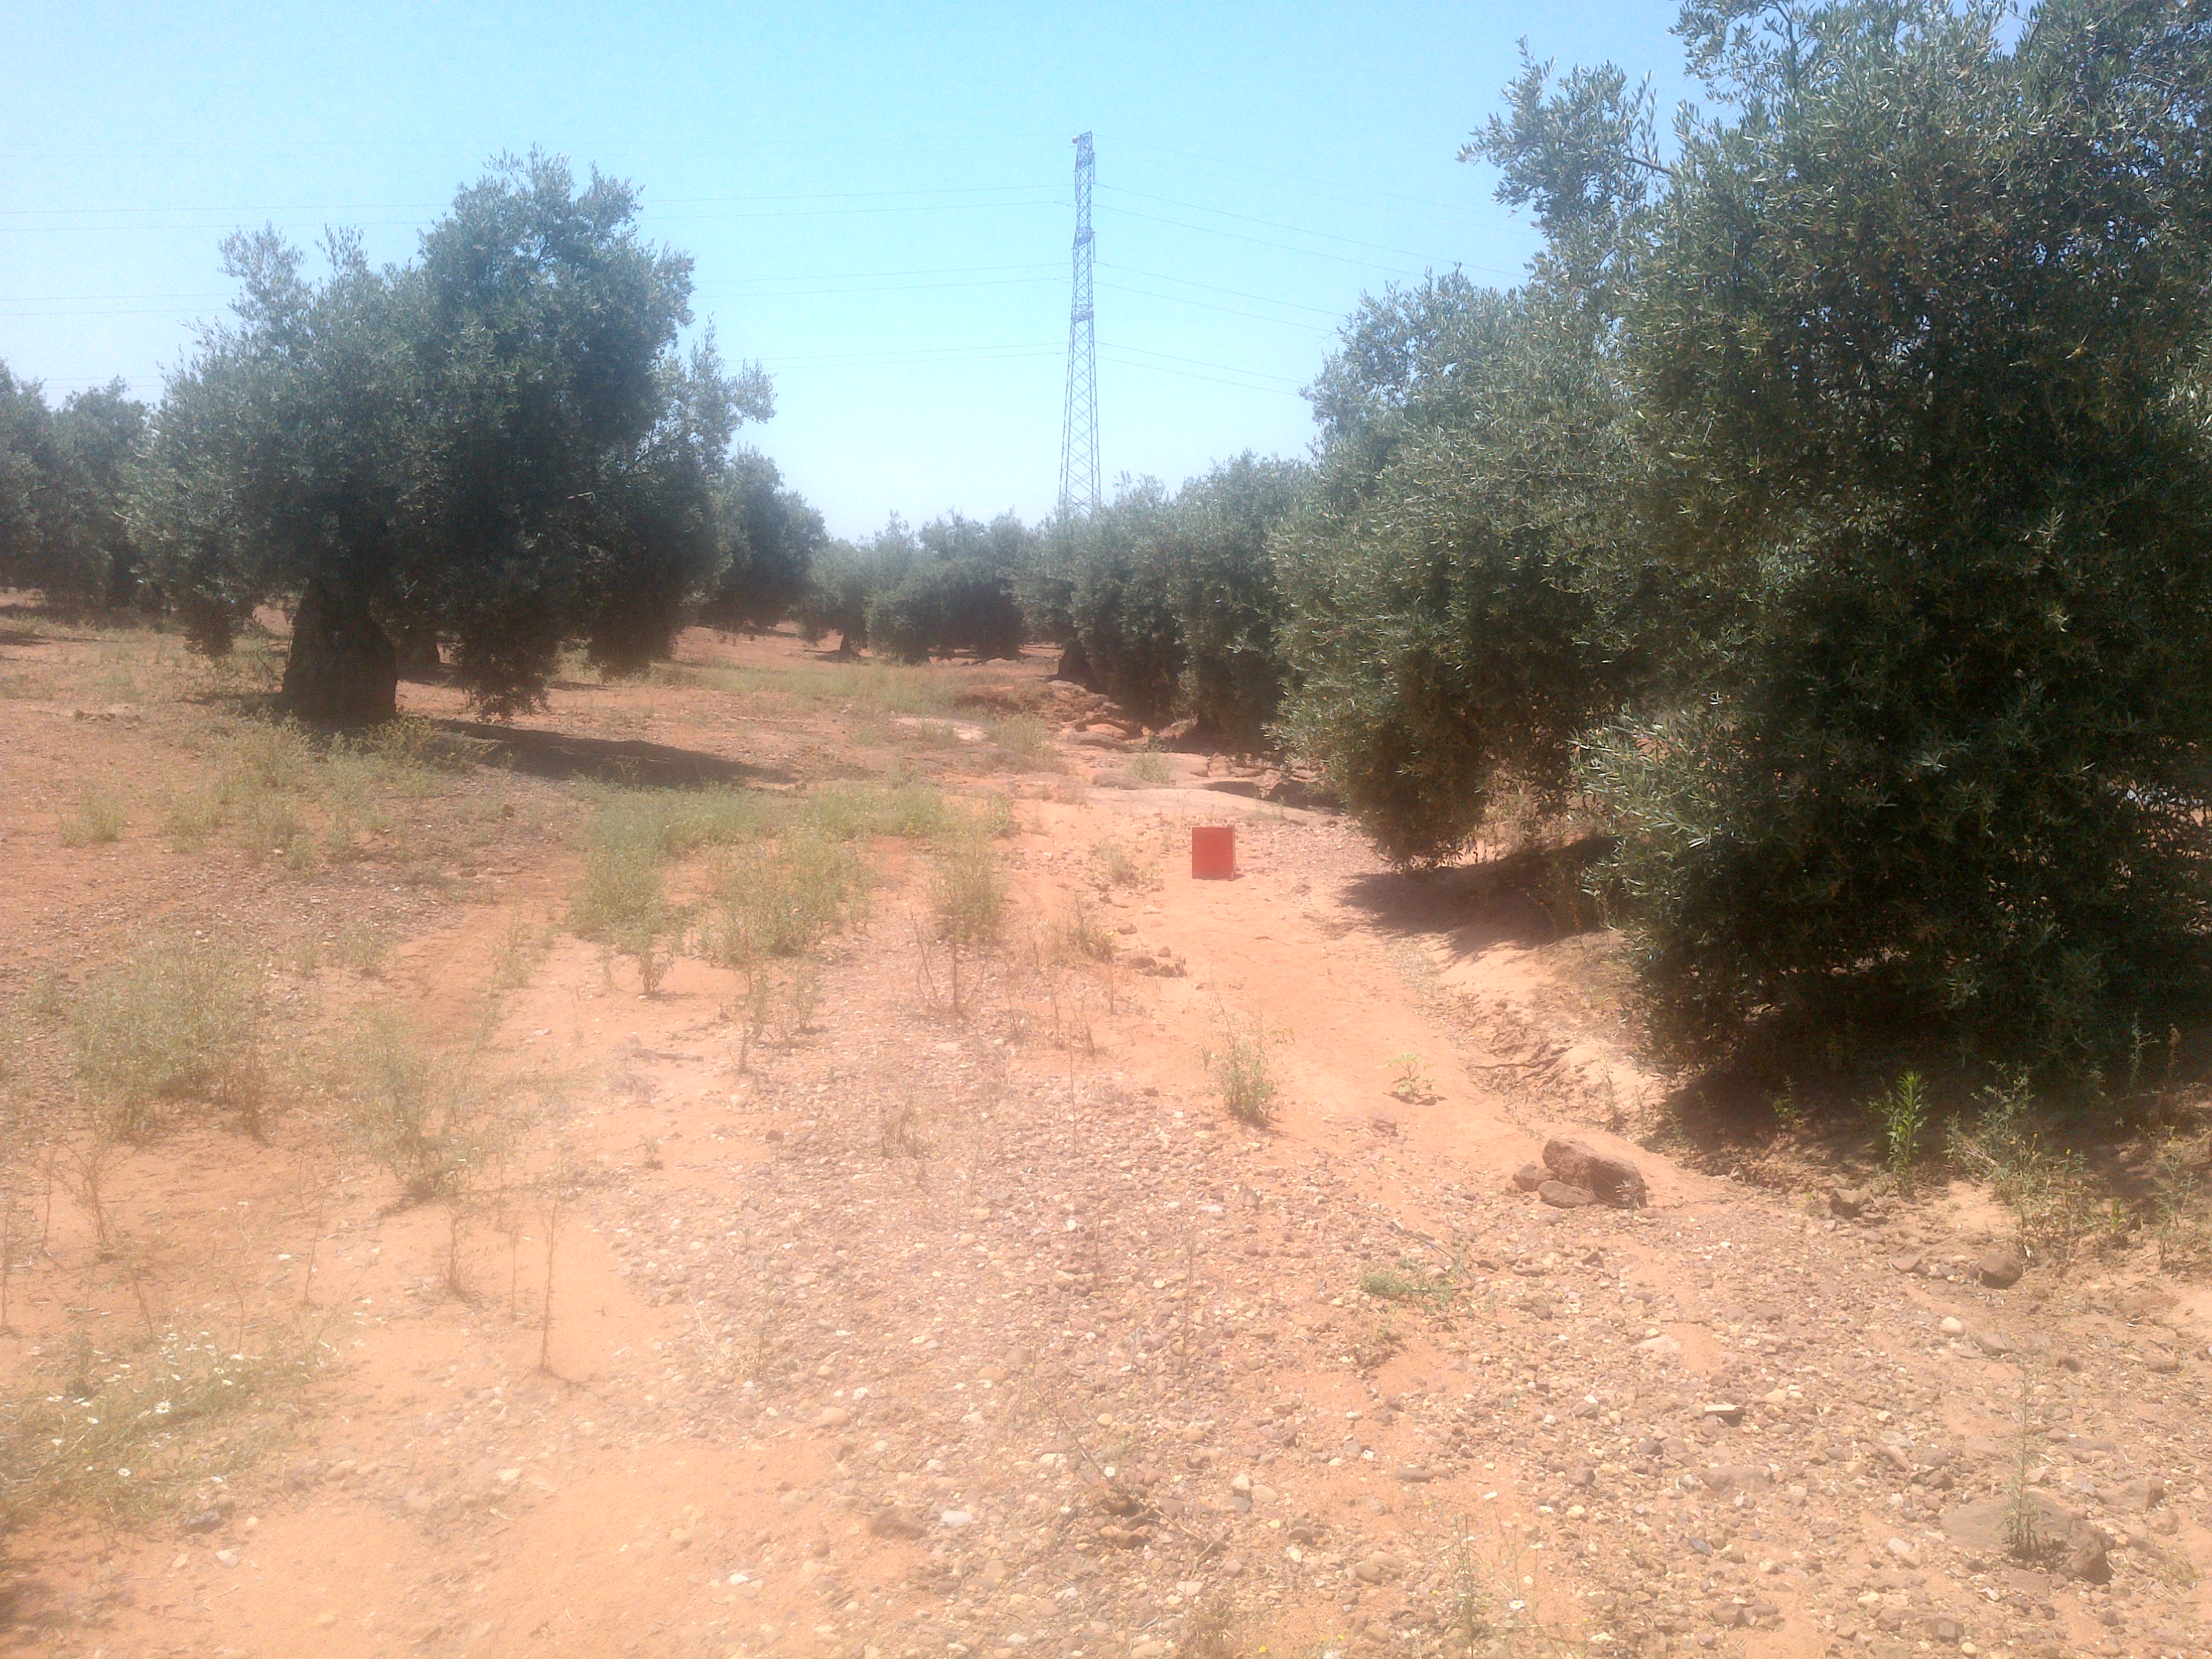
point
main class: Cropland
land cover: Olive groves
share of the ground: 50 - 75 %
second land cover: Spontaneously vegetated surfaces
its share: 10 - 25 %
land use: Agriculture (excluding fallow land and kitchen gardens)
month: June
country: ES
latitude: 38.0519
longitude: -4.3362
